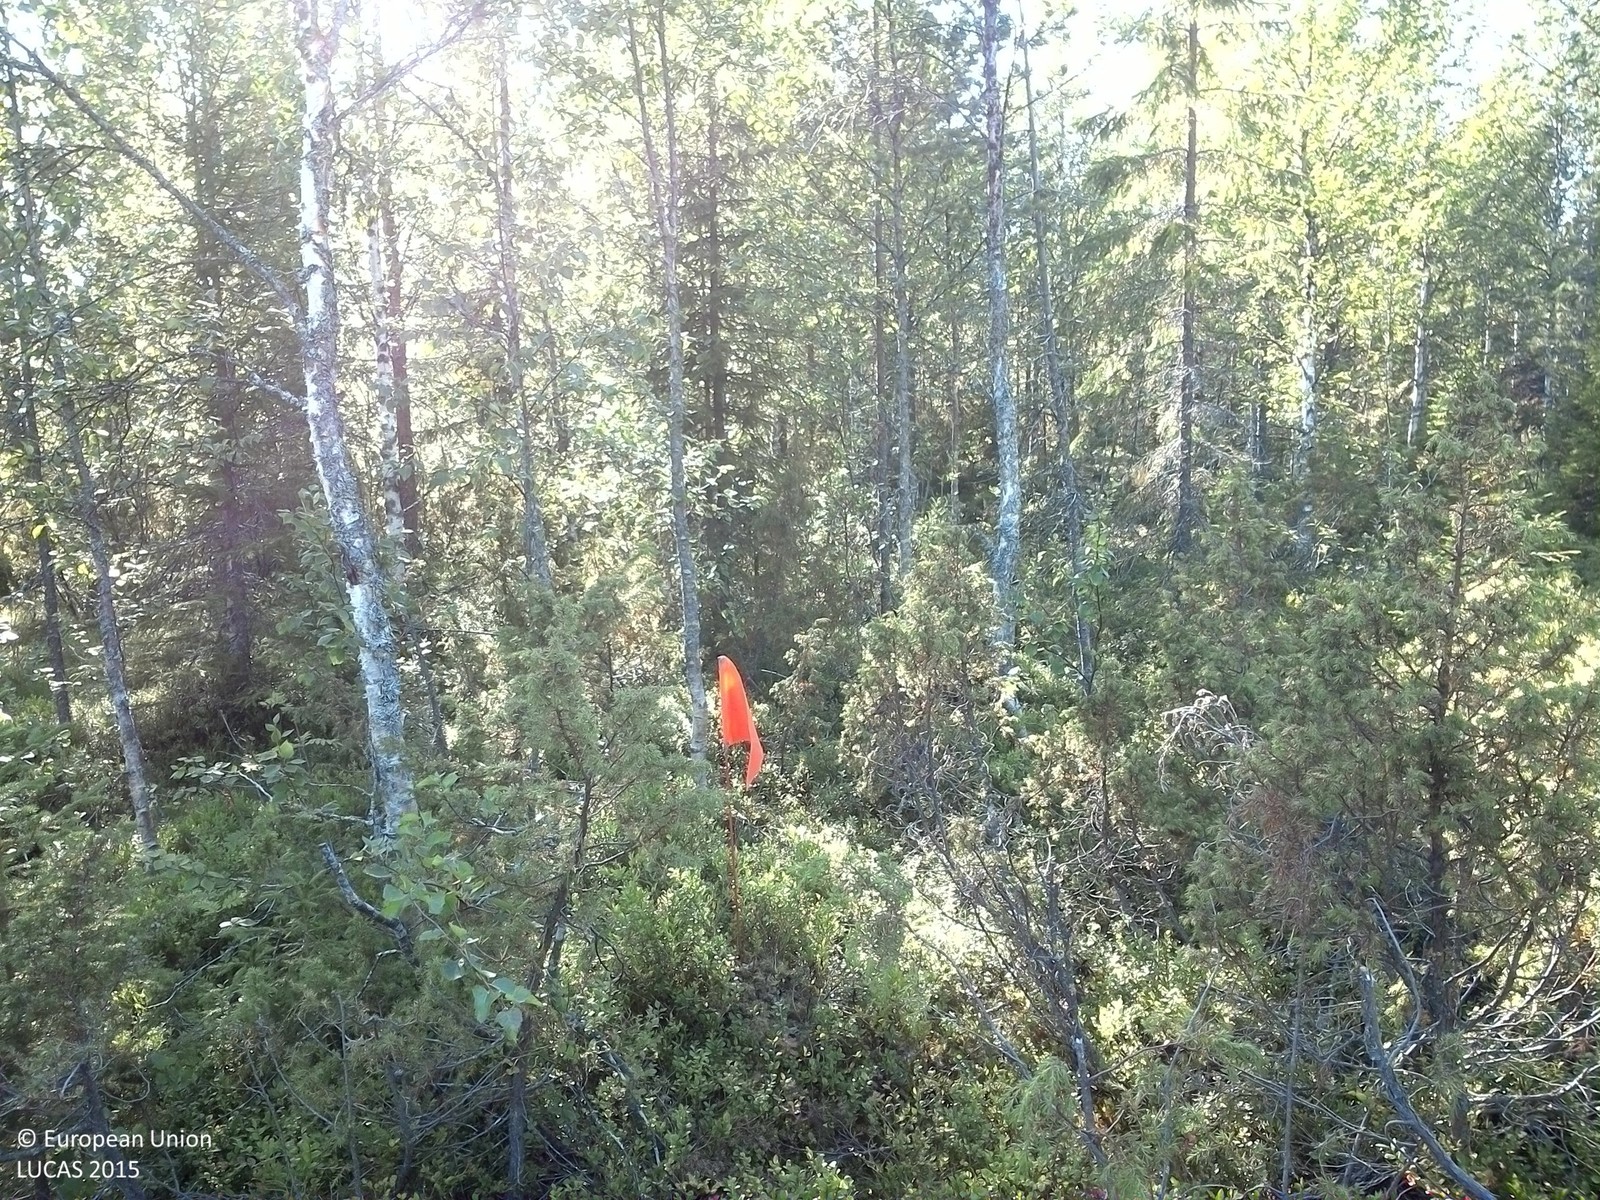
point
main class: Woodland
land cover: Other mixed woodland
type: boreal forest
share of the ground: > 75 %
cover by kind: coniferous forest trees 40 %, broadleaved forest trees 35 %, shrubs 25 %
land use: Forestry
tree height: < 5 m
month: August
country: SE
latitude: 63.8172
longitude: 17.5895
